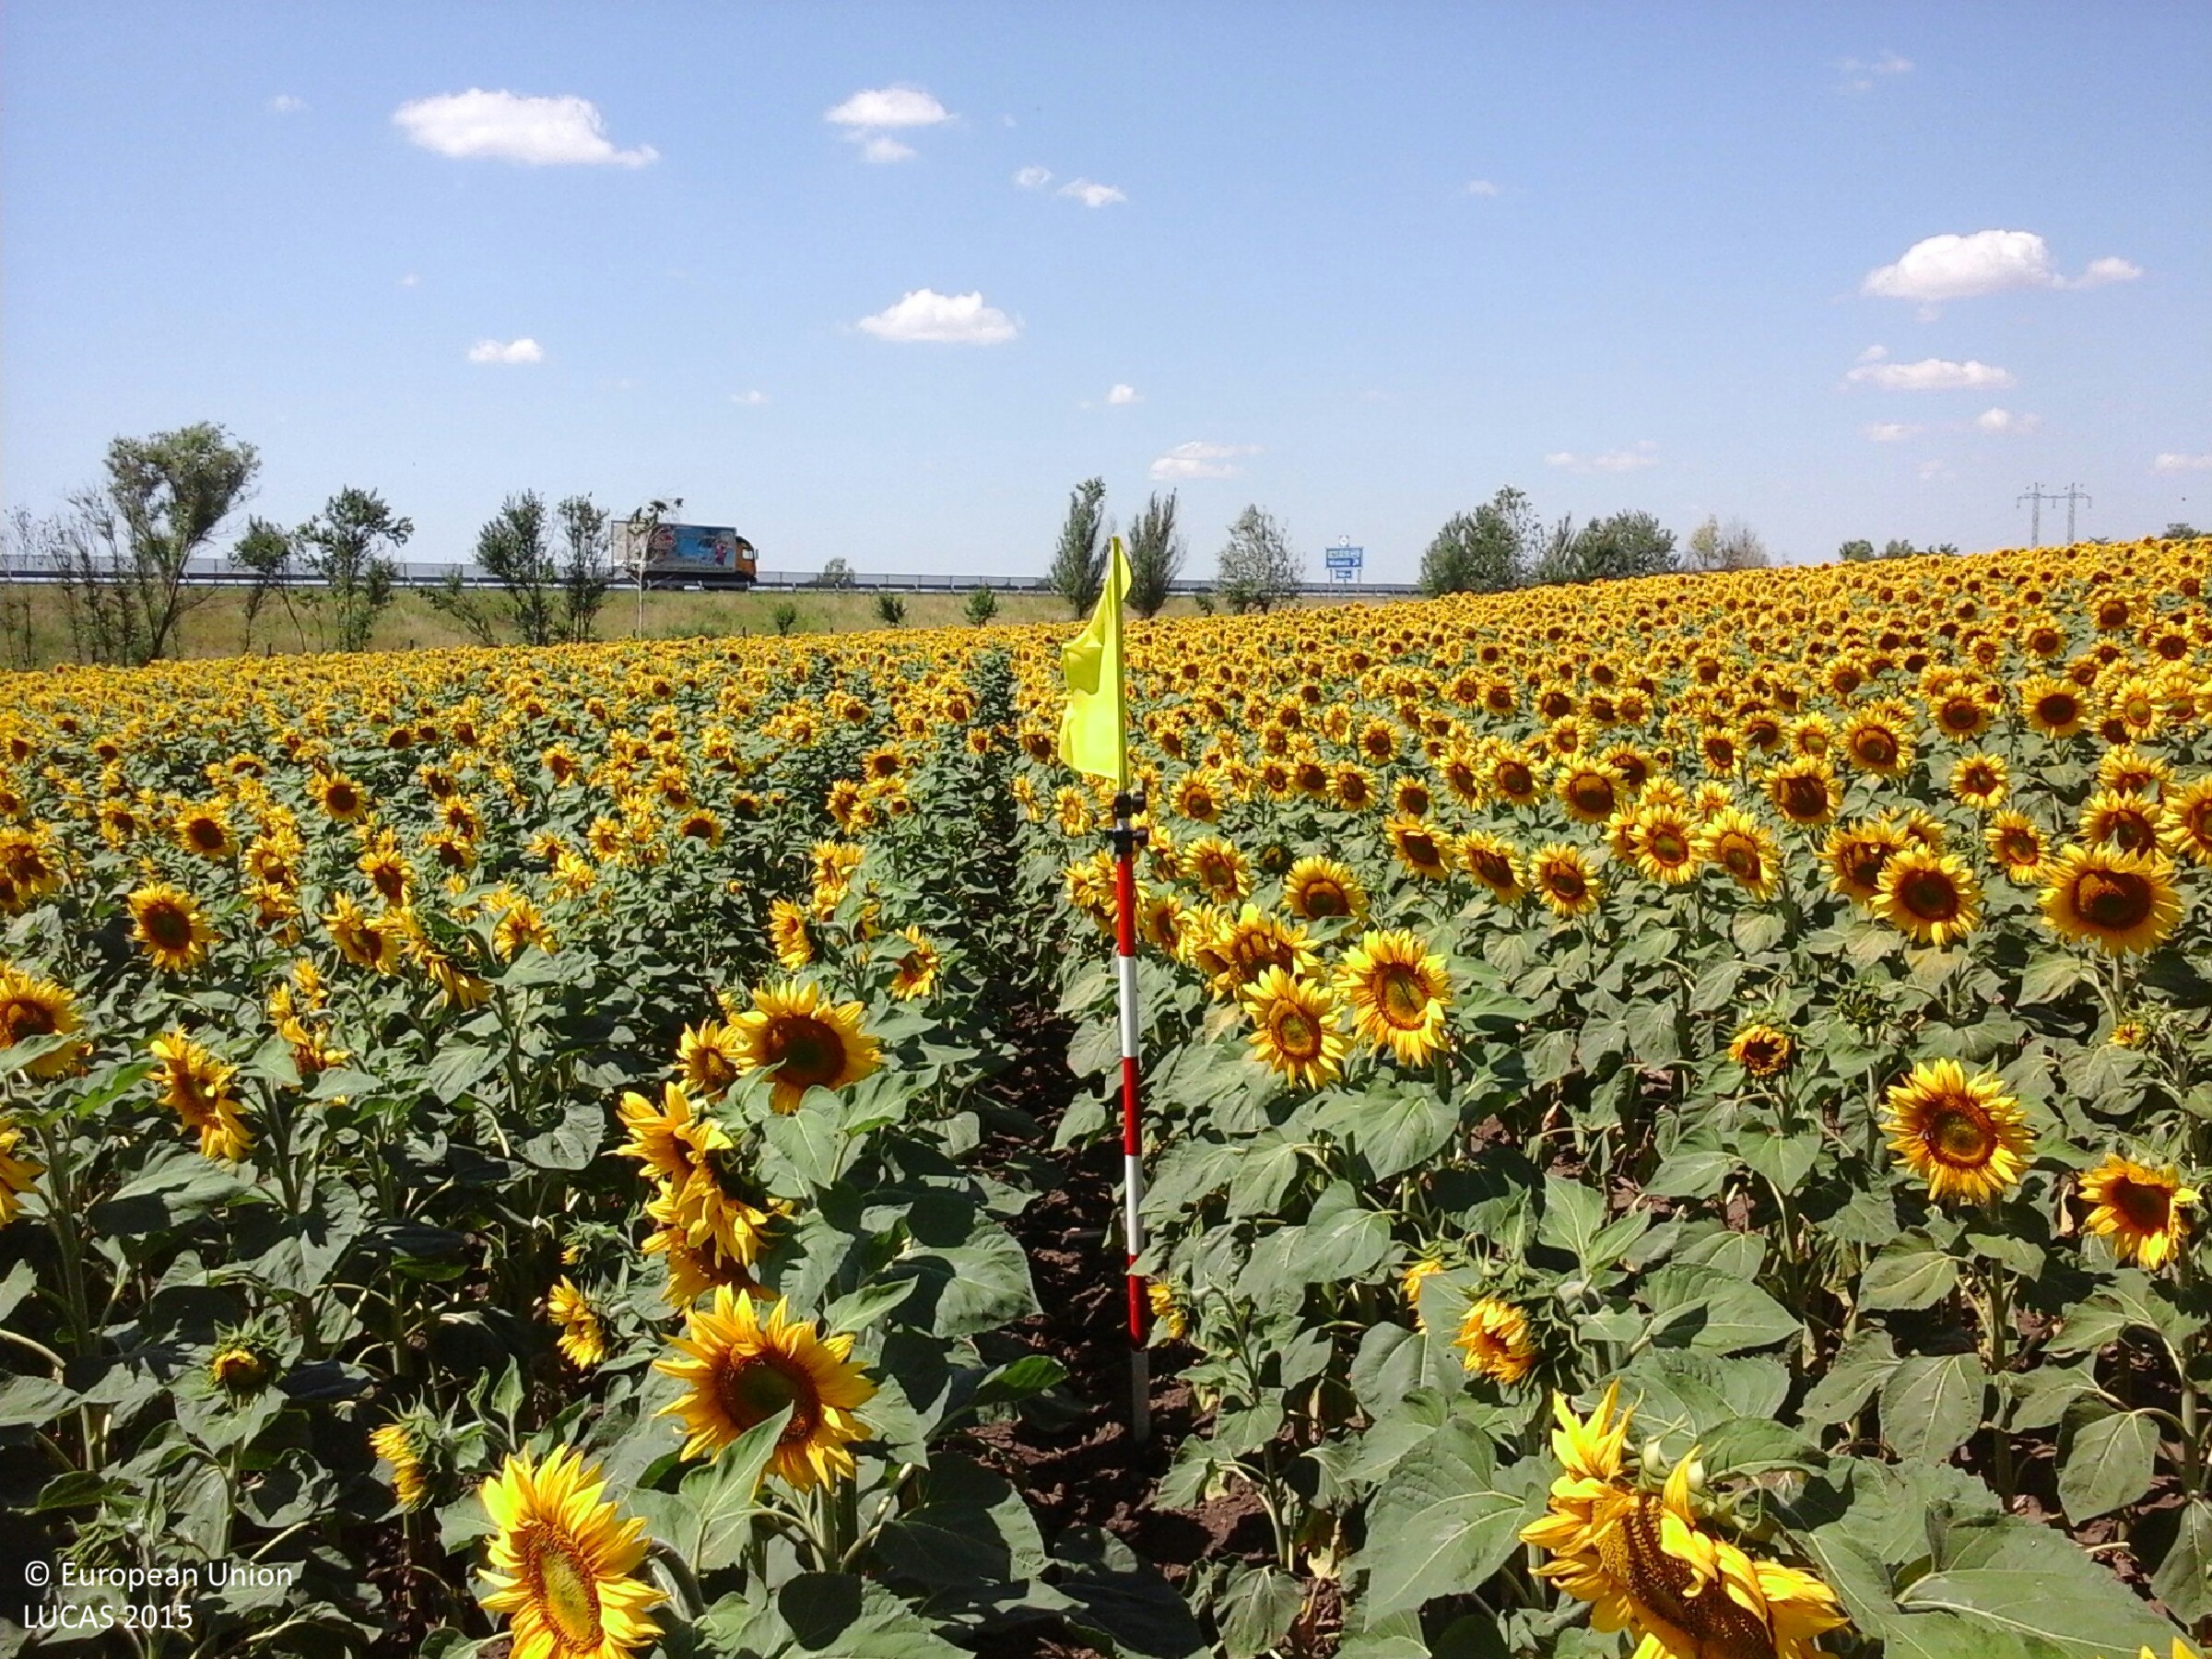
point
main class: Cropland
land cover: Sunflower
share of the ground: > 75 %
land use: Agriculture (excluding fallow land and kitchen gardens)
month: July
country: HU
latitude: 47.8855
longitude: 20.8555
